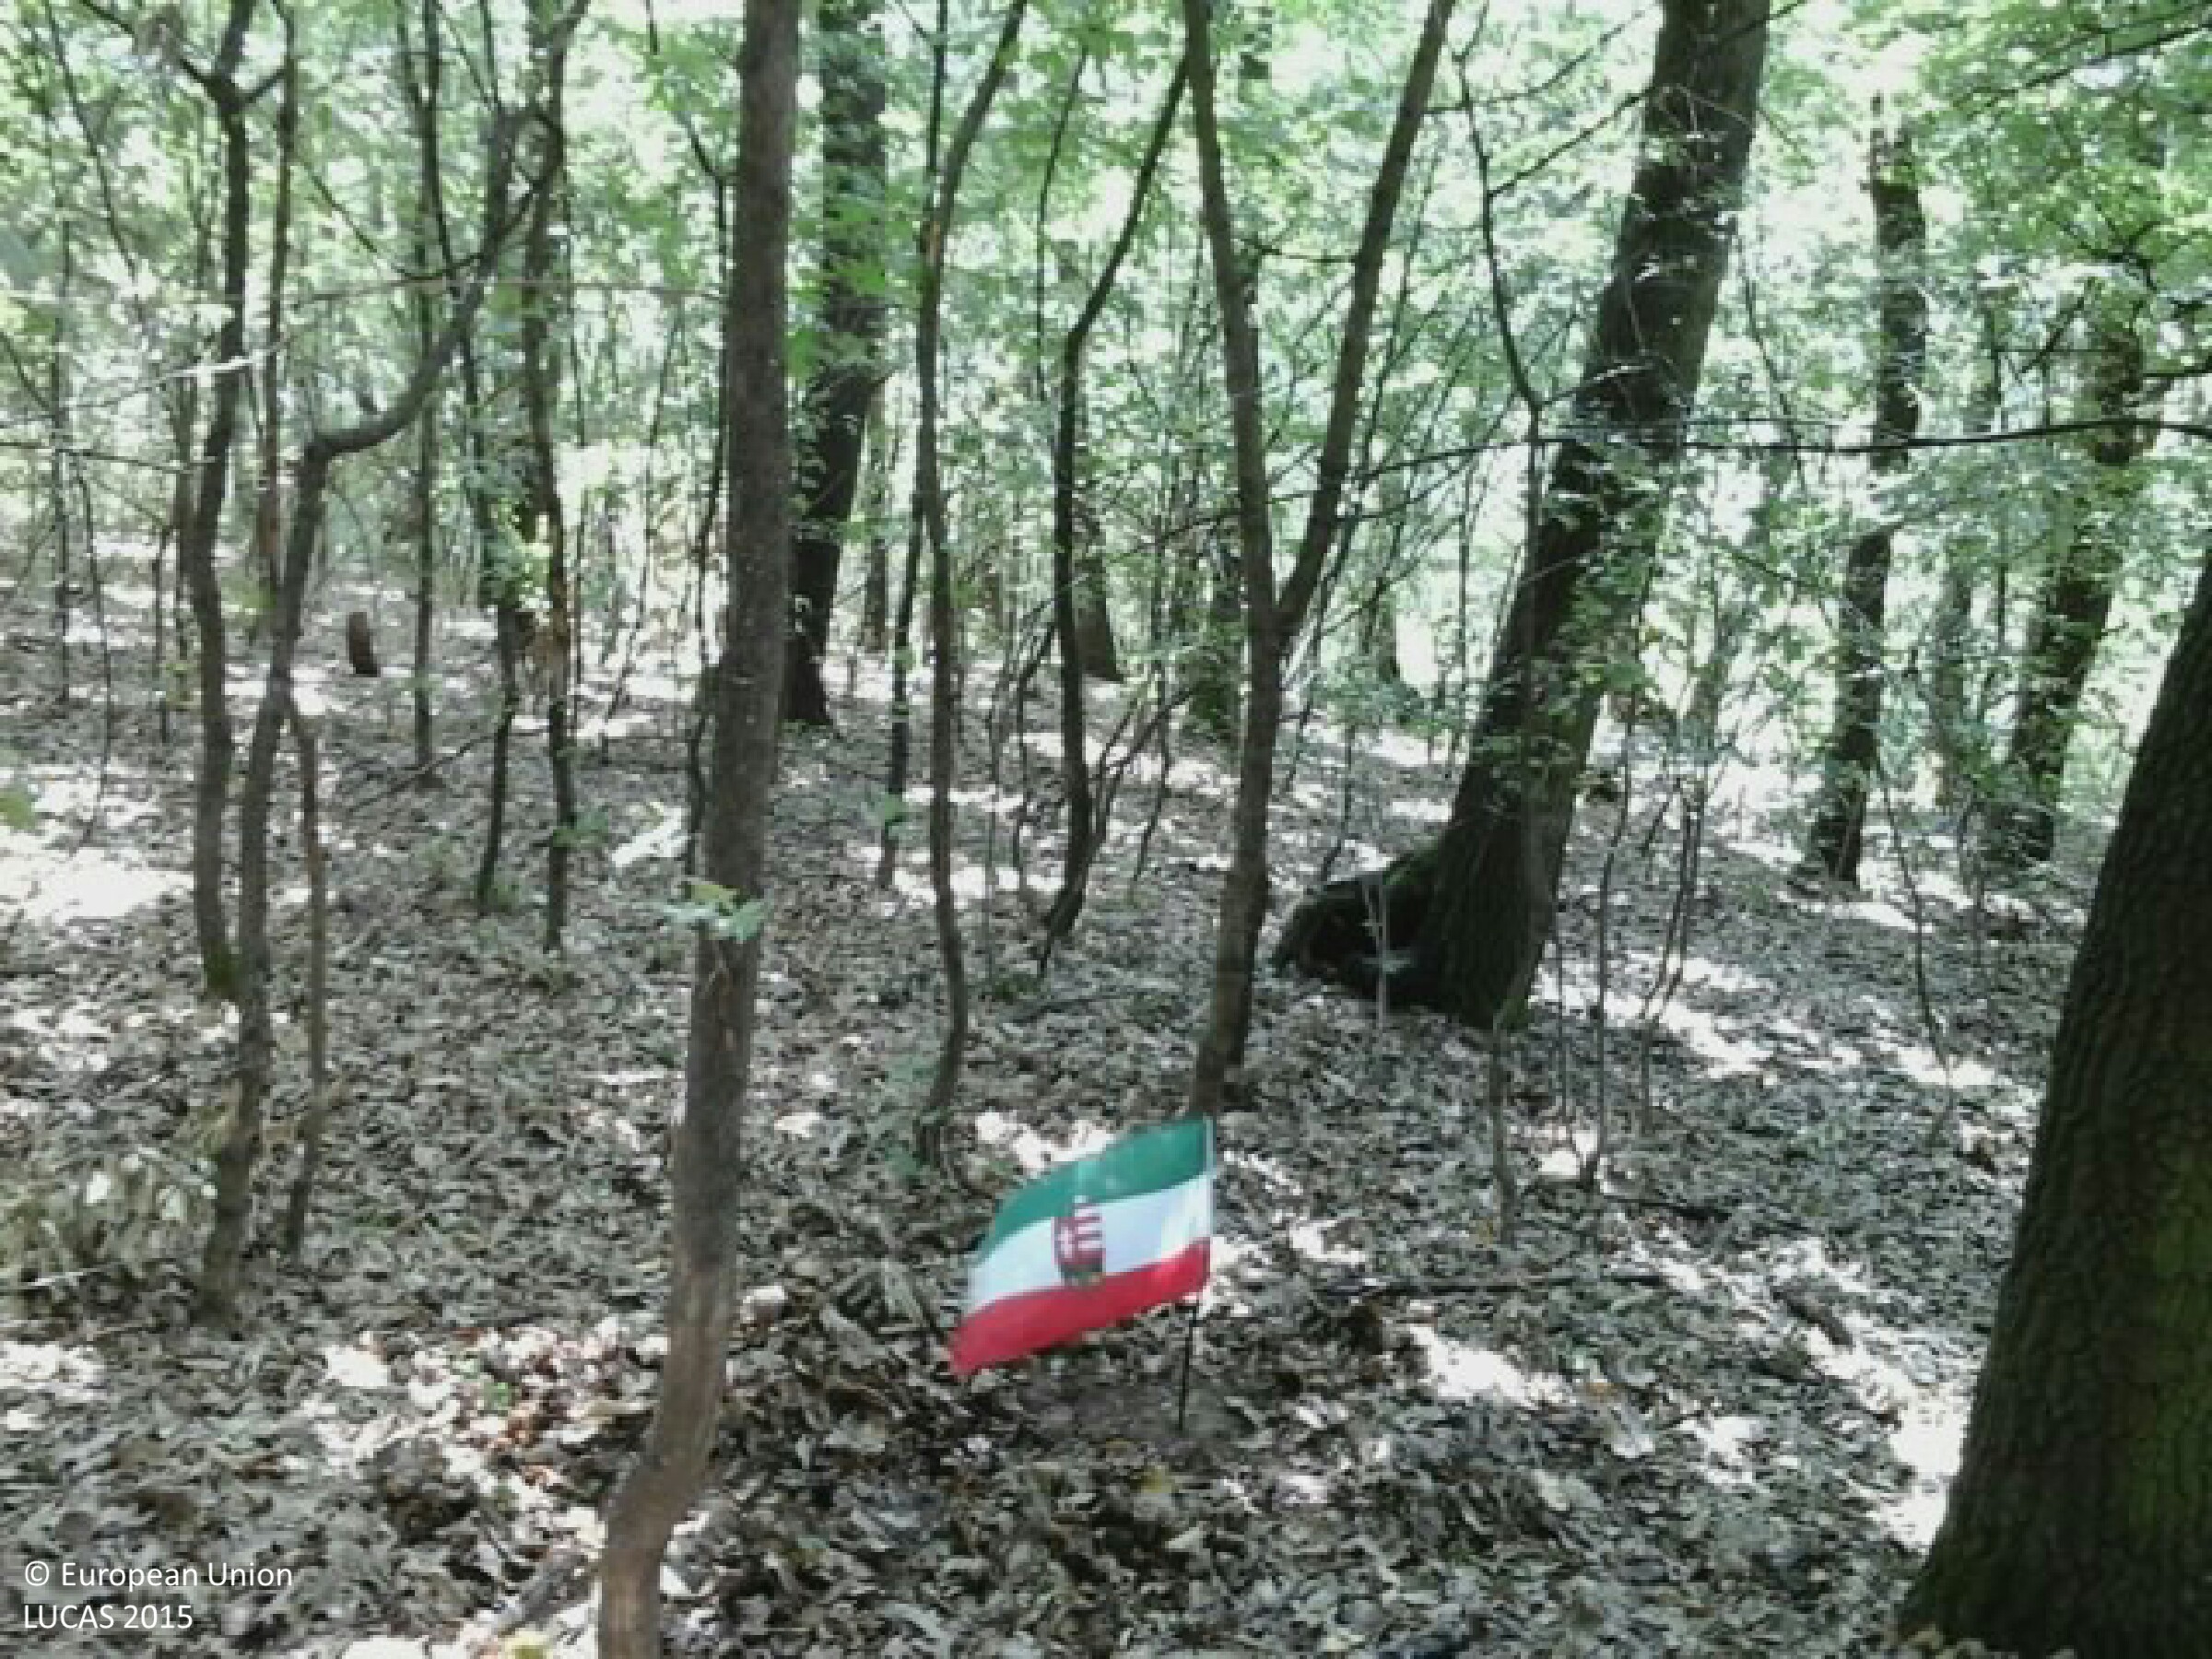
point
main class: Woodland
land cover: Broadleaved woodland
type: mesophytic deciduous forest
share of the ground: > 75 %
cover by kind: broadleaved forest trees 100 %
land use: Forestry
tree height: > 5 m
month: July
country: HU
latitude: 47.8649
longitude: 19.0962
